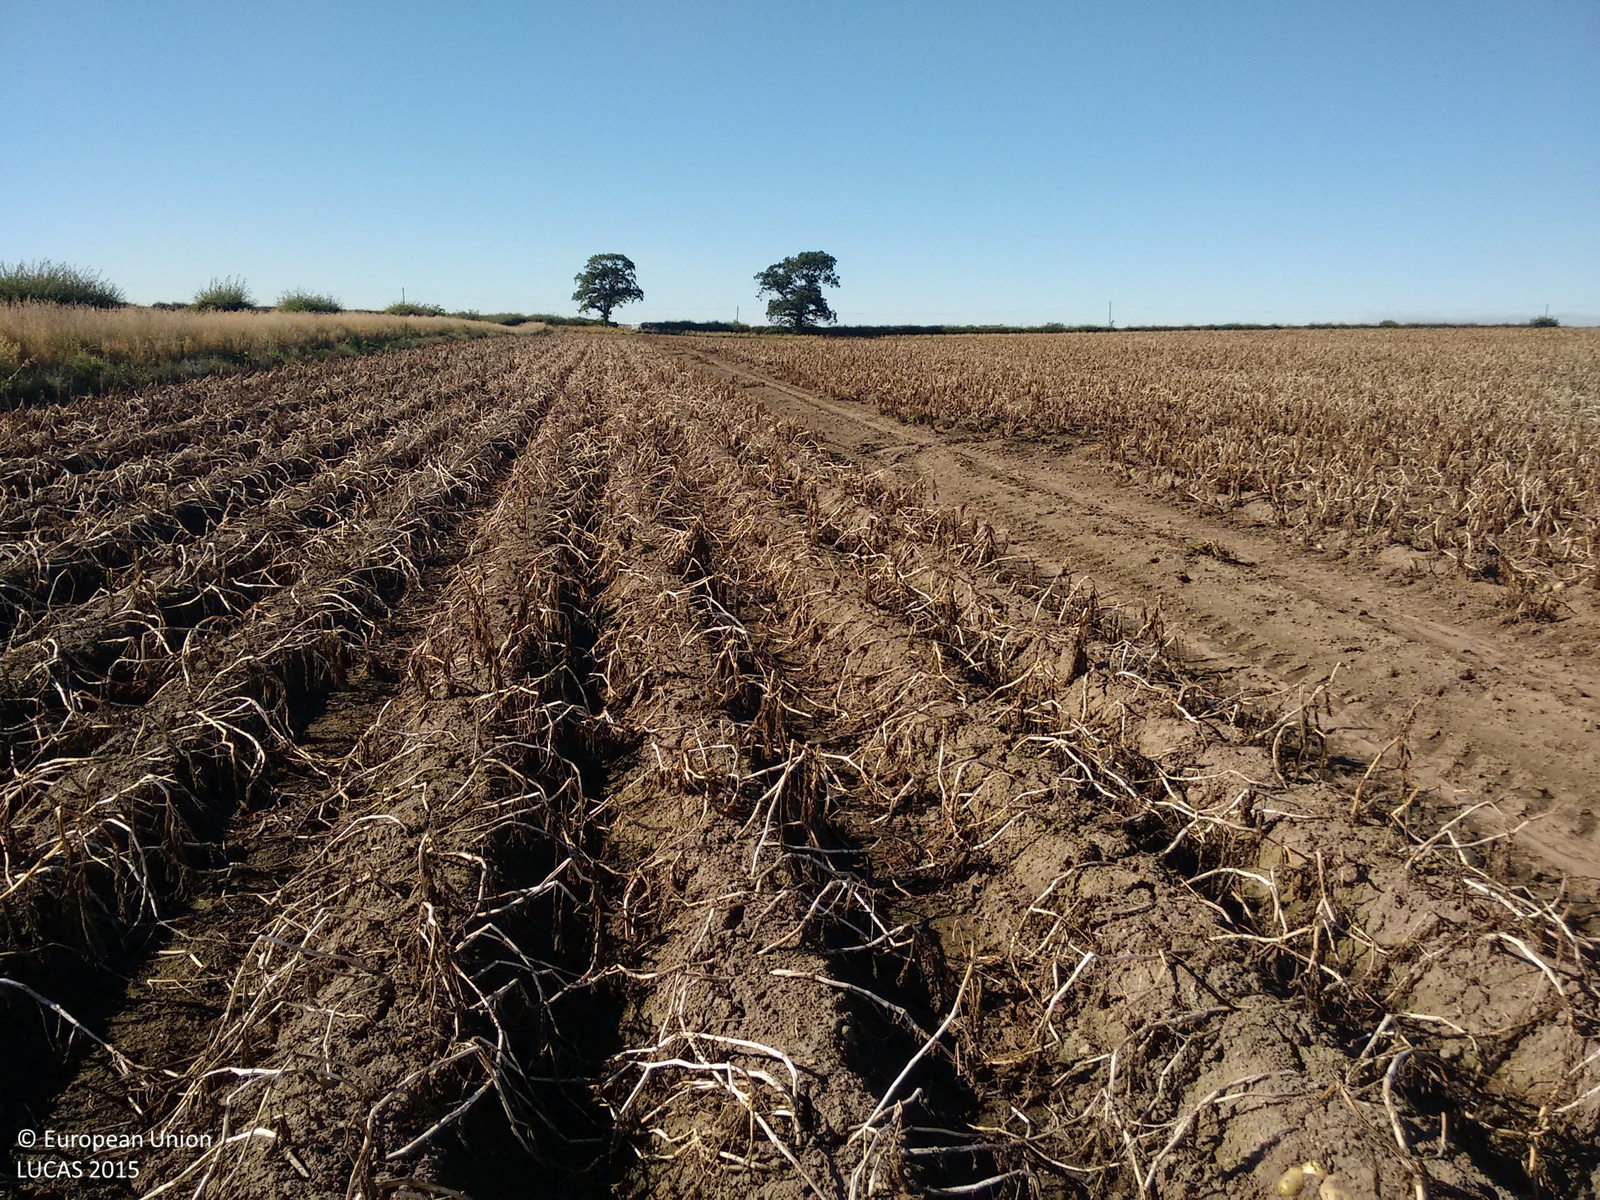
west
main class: Cropland
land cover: Potatoes
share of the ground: > 75 %
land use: Agriculture (excluding fallow land and kitchen gardens)
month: October
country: GB
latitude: 56.6984
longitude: -2.5503
